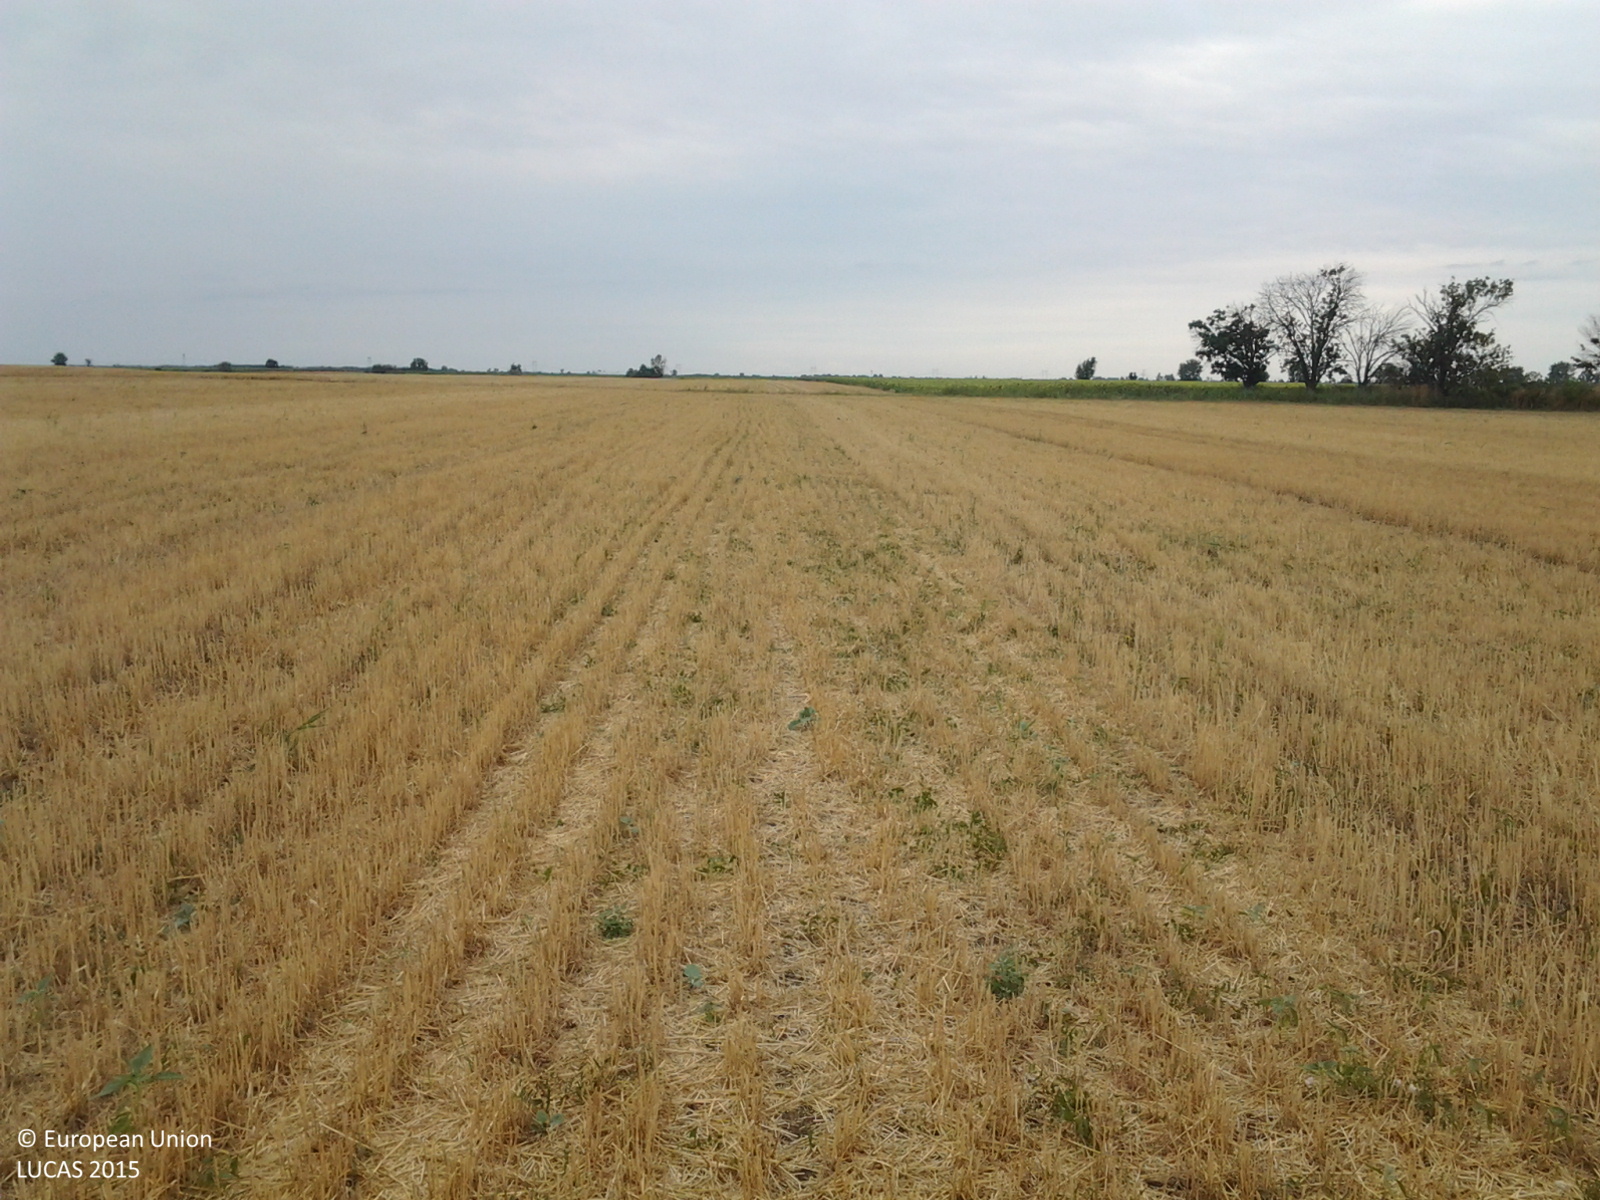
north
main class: Cropland
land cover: Common wheat
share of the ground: < 10 %
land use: Agriculture (excluding fallow land and kitchen gardens)
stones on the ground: < 10 %
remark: Harvested field
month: July
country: HU
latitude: 47.2883
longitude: 20.8364
